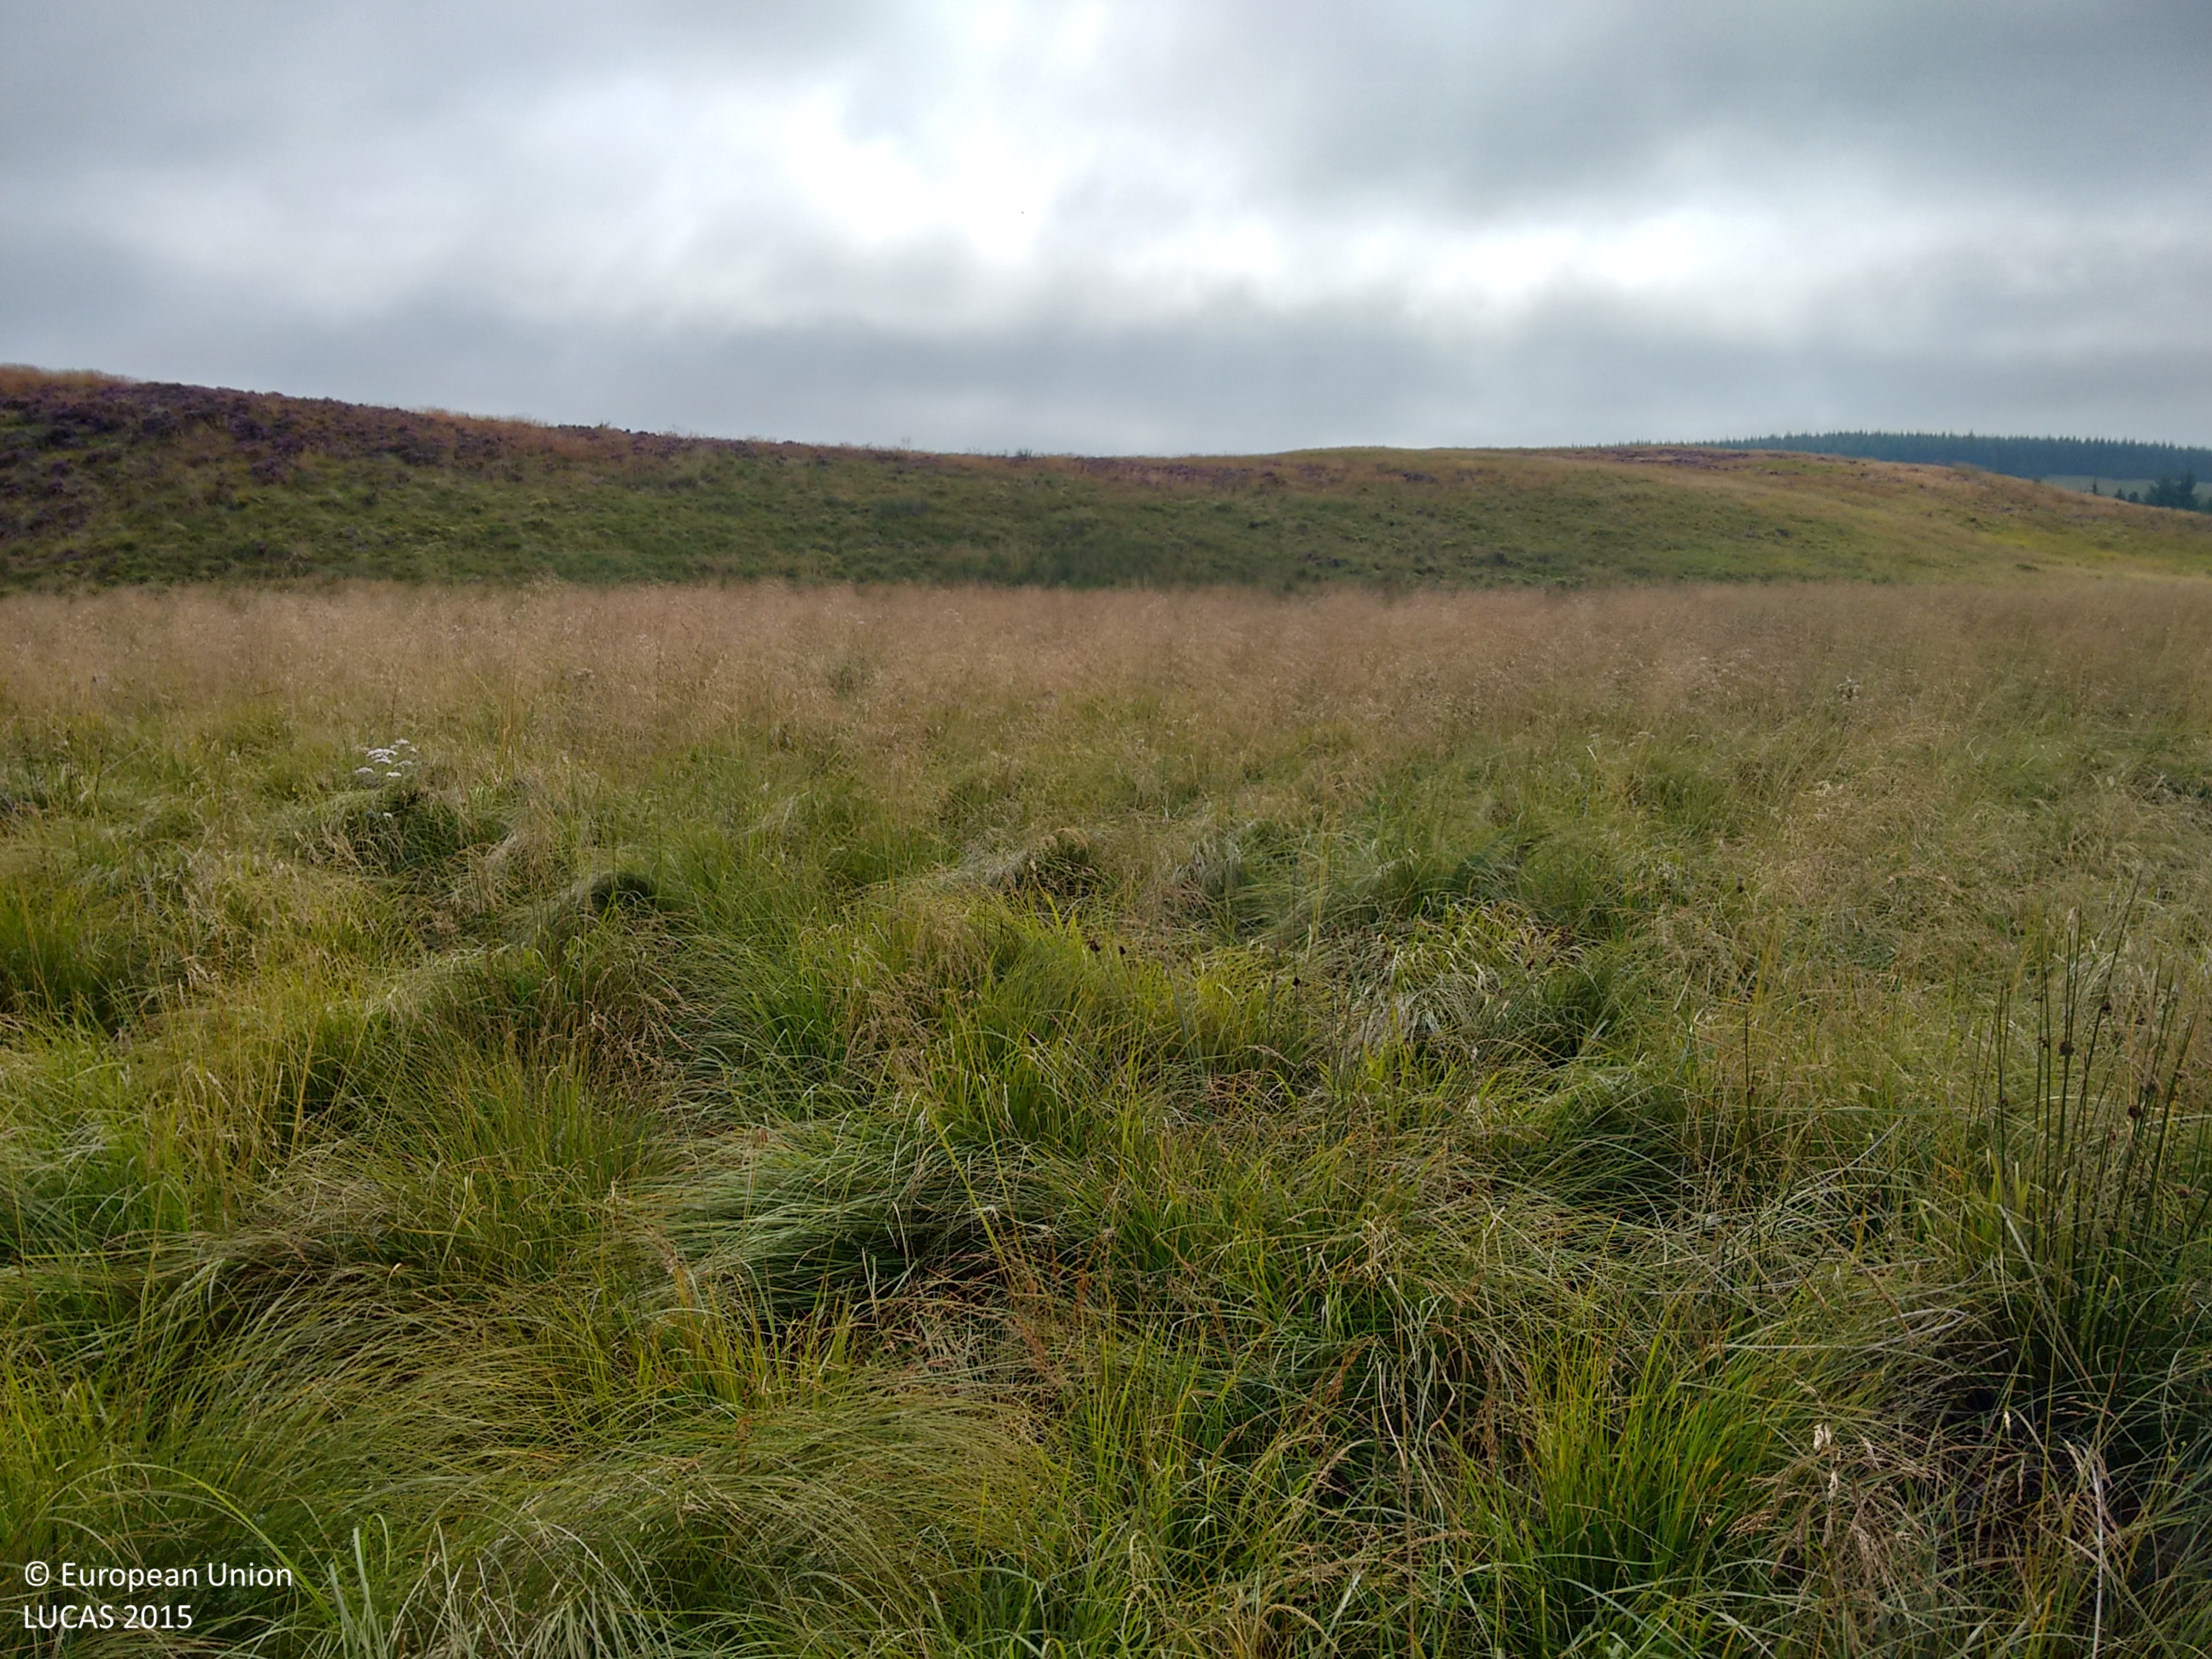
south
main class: Grassland
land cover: Grassland without tree/shrub cover
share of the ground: > 75 %
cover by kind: herbaceous plants 100 %
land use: Agriculture (excluding fallow land and kitchen gardens)
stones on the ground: < 10 %
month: September
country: GB
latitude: 58.0991
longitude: -4.3876
